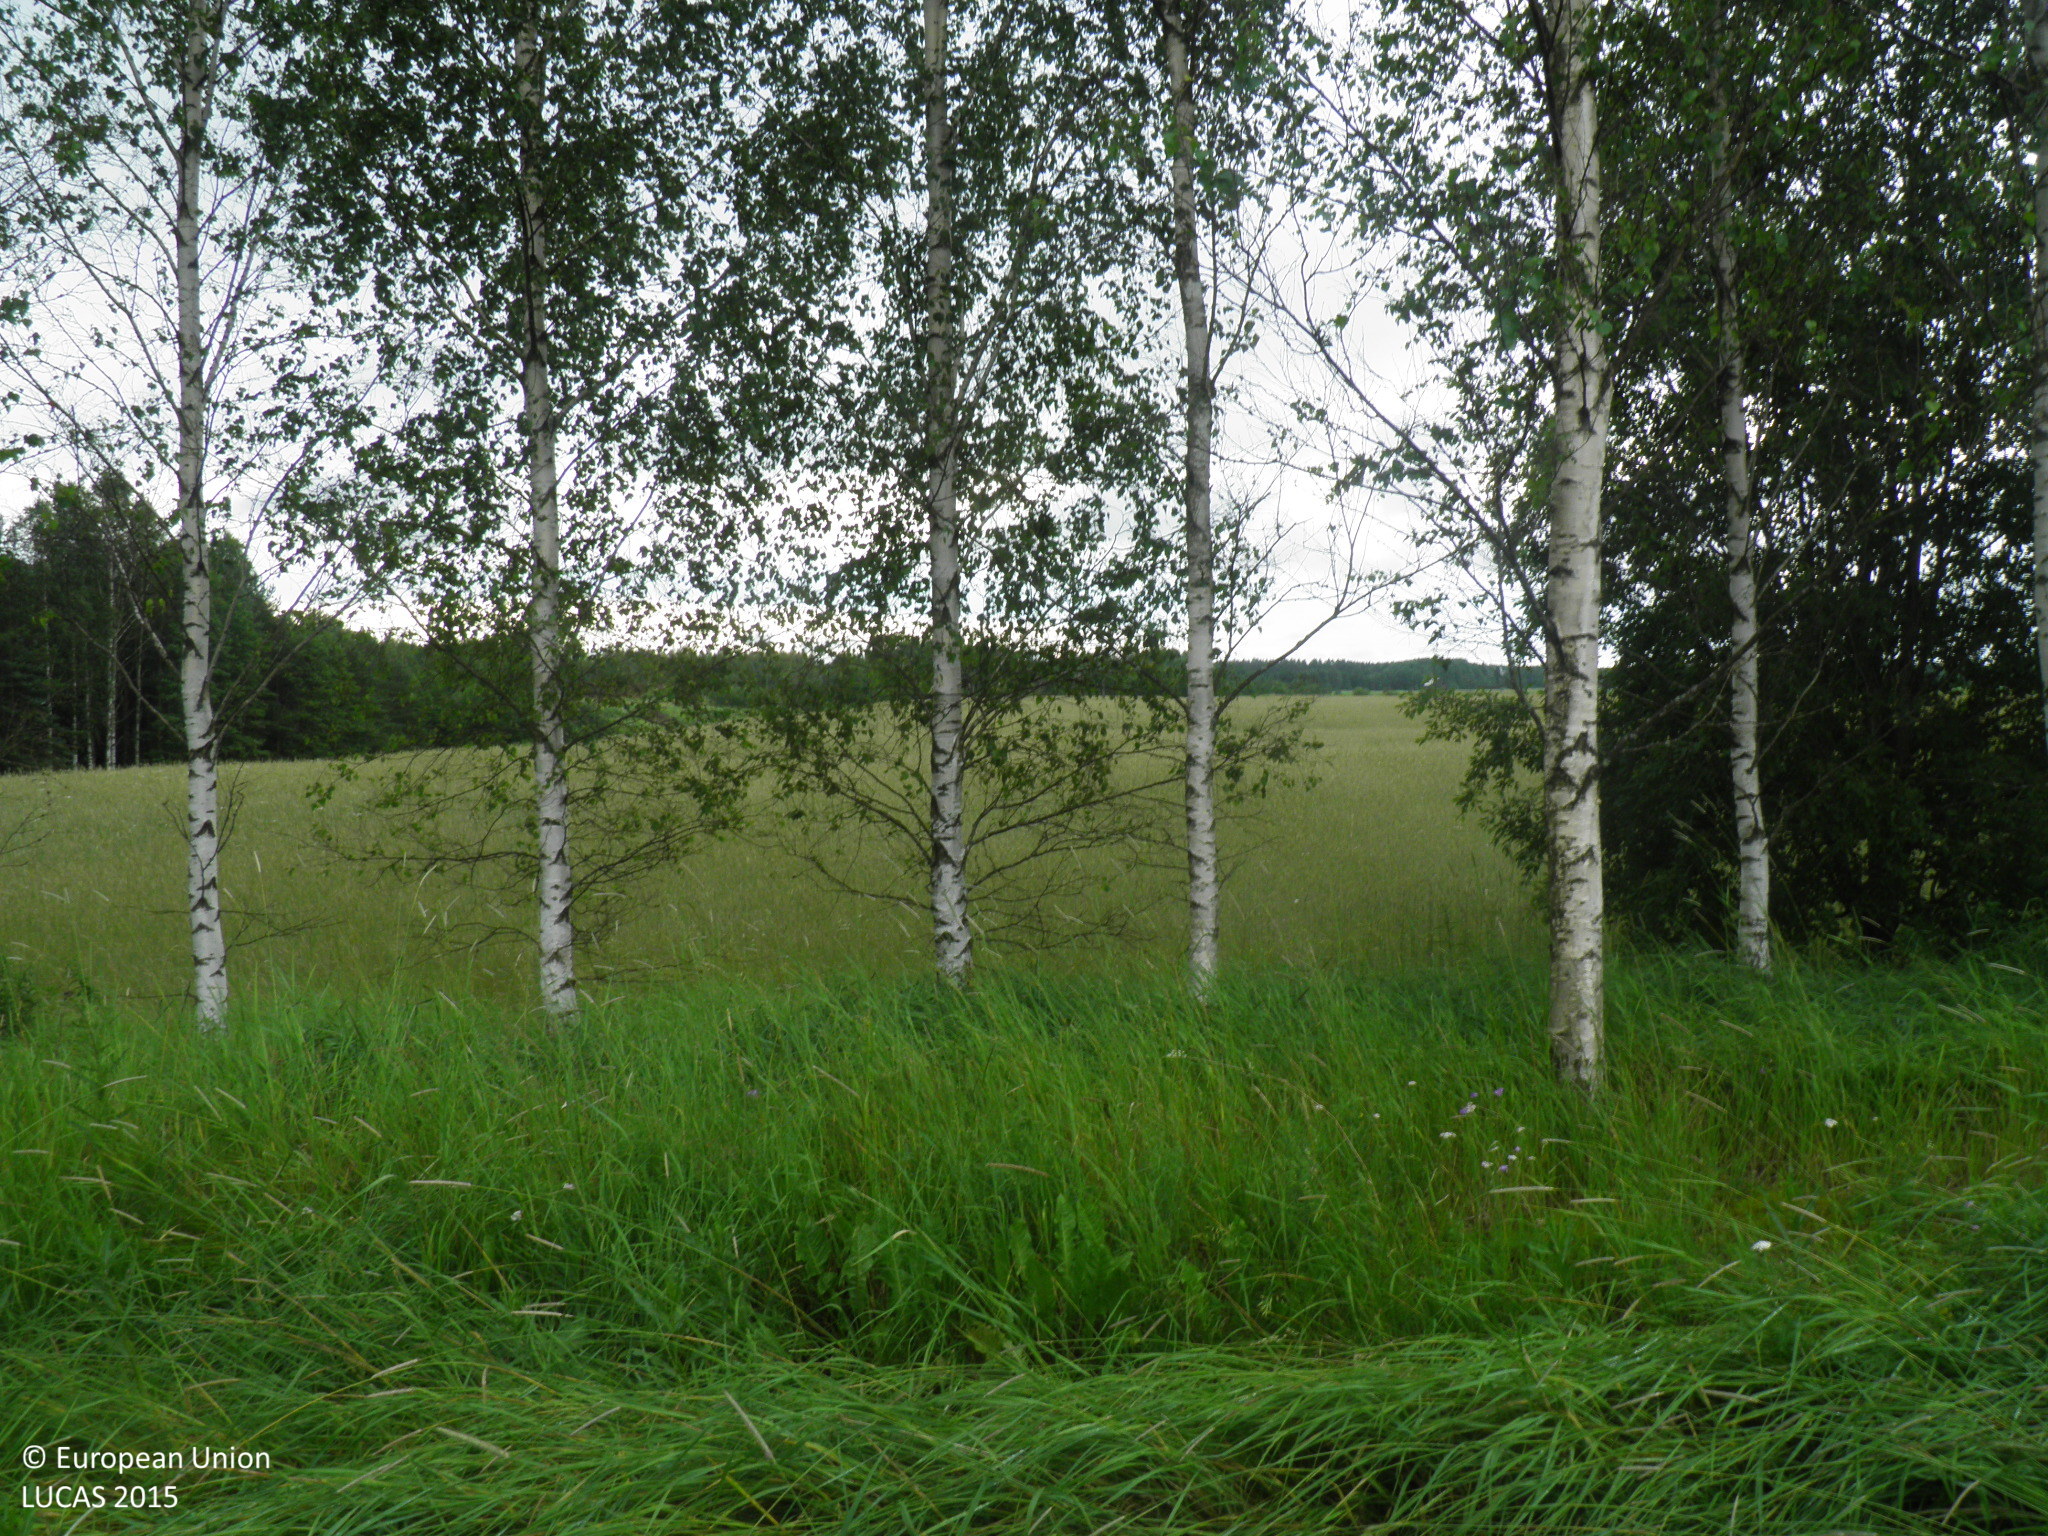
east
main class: Grassland
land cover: Grassland without tree/shrub cover
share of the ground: > 75 %
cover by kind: herbaceous plants 100 %
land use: Agriculture (excluding fallow land and kitchen gardens)
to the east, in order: Grassland without tree/shrub cover; Ditches and canals; Broadleaved woodland; Ditches and canals; Grass margins; Common wheat; Electric lines; Common wheat
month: July
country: FI
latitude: 60.6203
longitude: 22.7735
